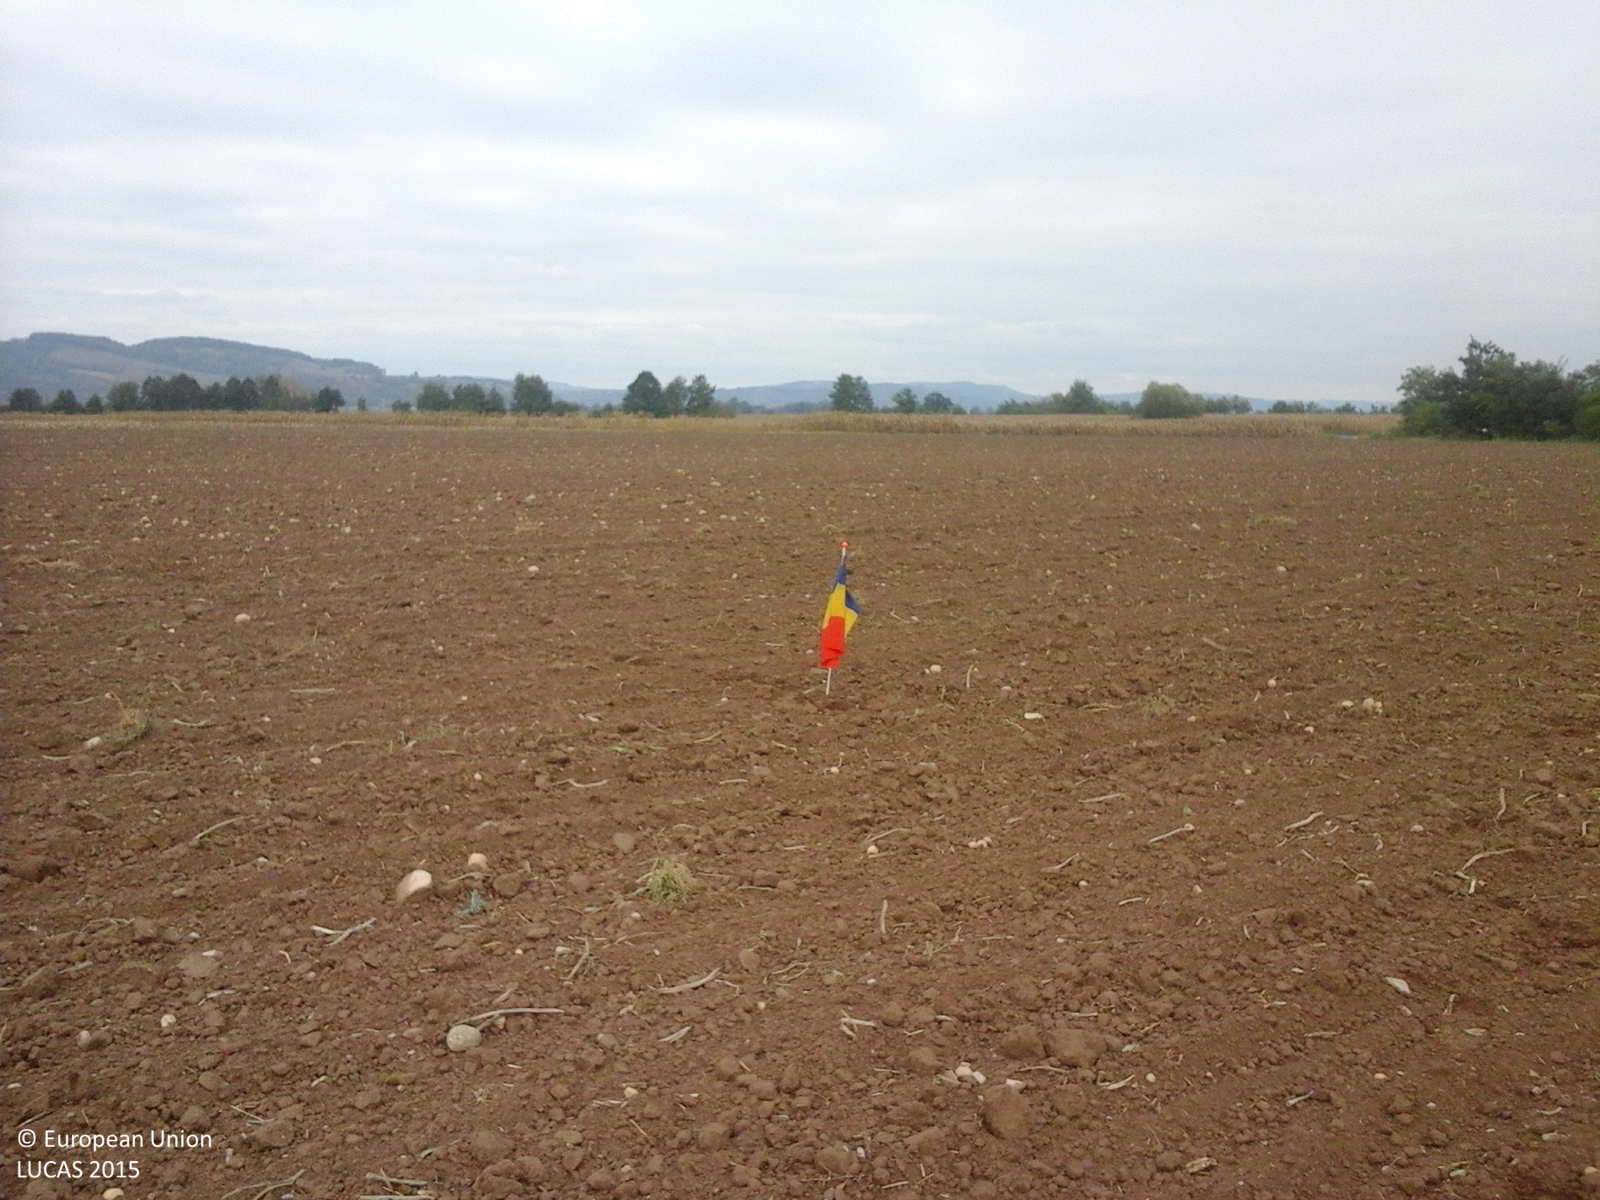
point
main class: Cropland
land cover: Potatoes
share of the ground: 50 - 75 %
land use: Agriculture (excluding fallow land and kitchen gardens)
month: October
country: RO
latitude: 45.7916
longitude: 24.7915
